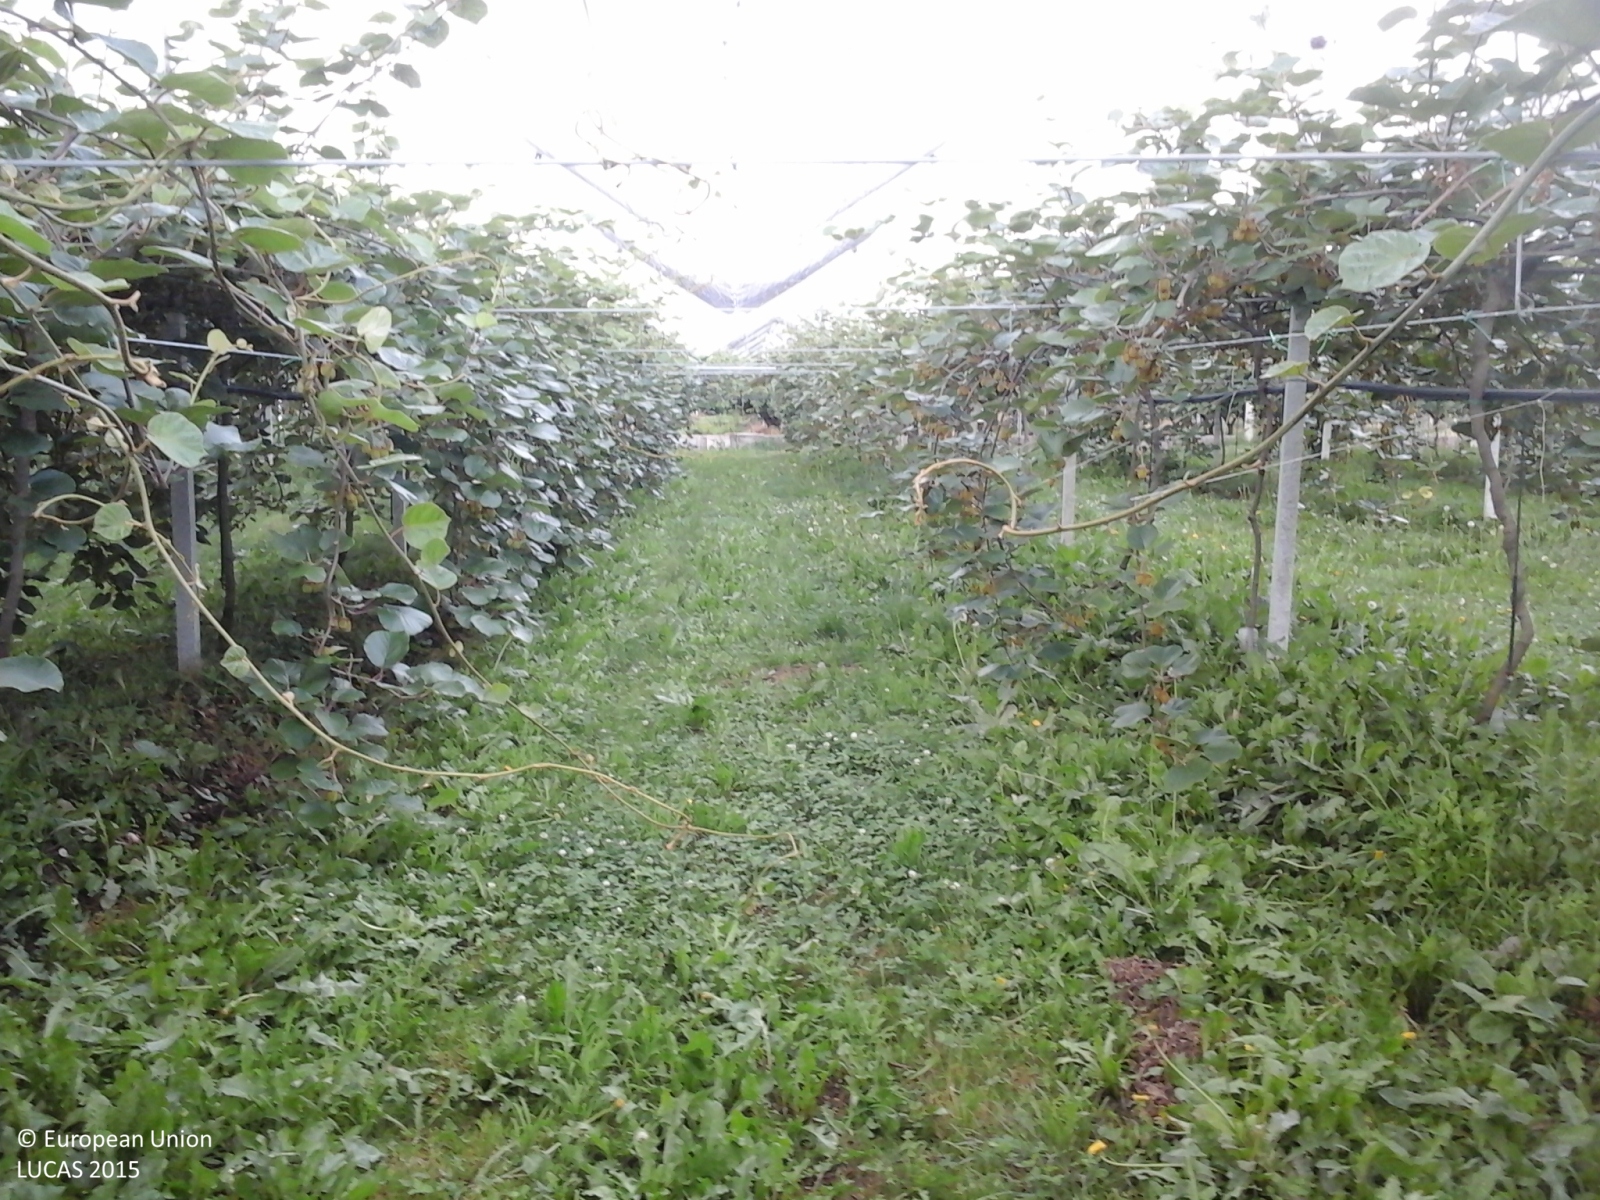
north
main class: Cropland
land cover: Other fruit trees and berries
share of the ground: 50 - 75 %
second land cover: Grassland without tree/shrub cover
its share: > 75 %
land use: Agriculture (excluding fallow land and kitchen gardens)
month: June
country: IT
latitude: 45.4284
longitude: 10.9059
